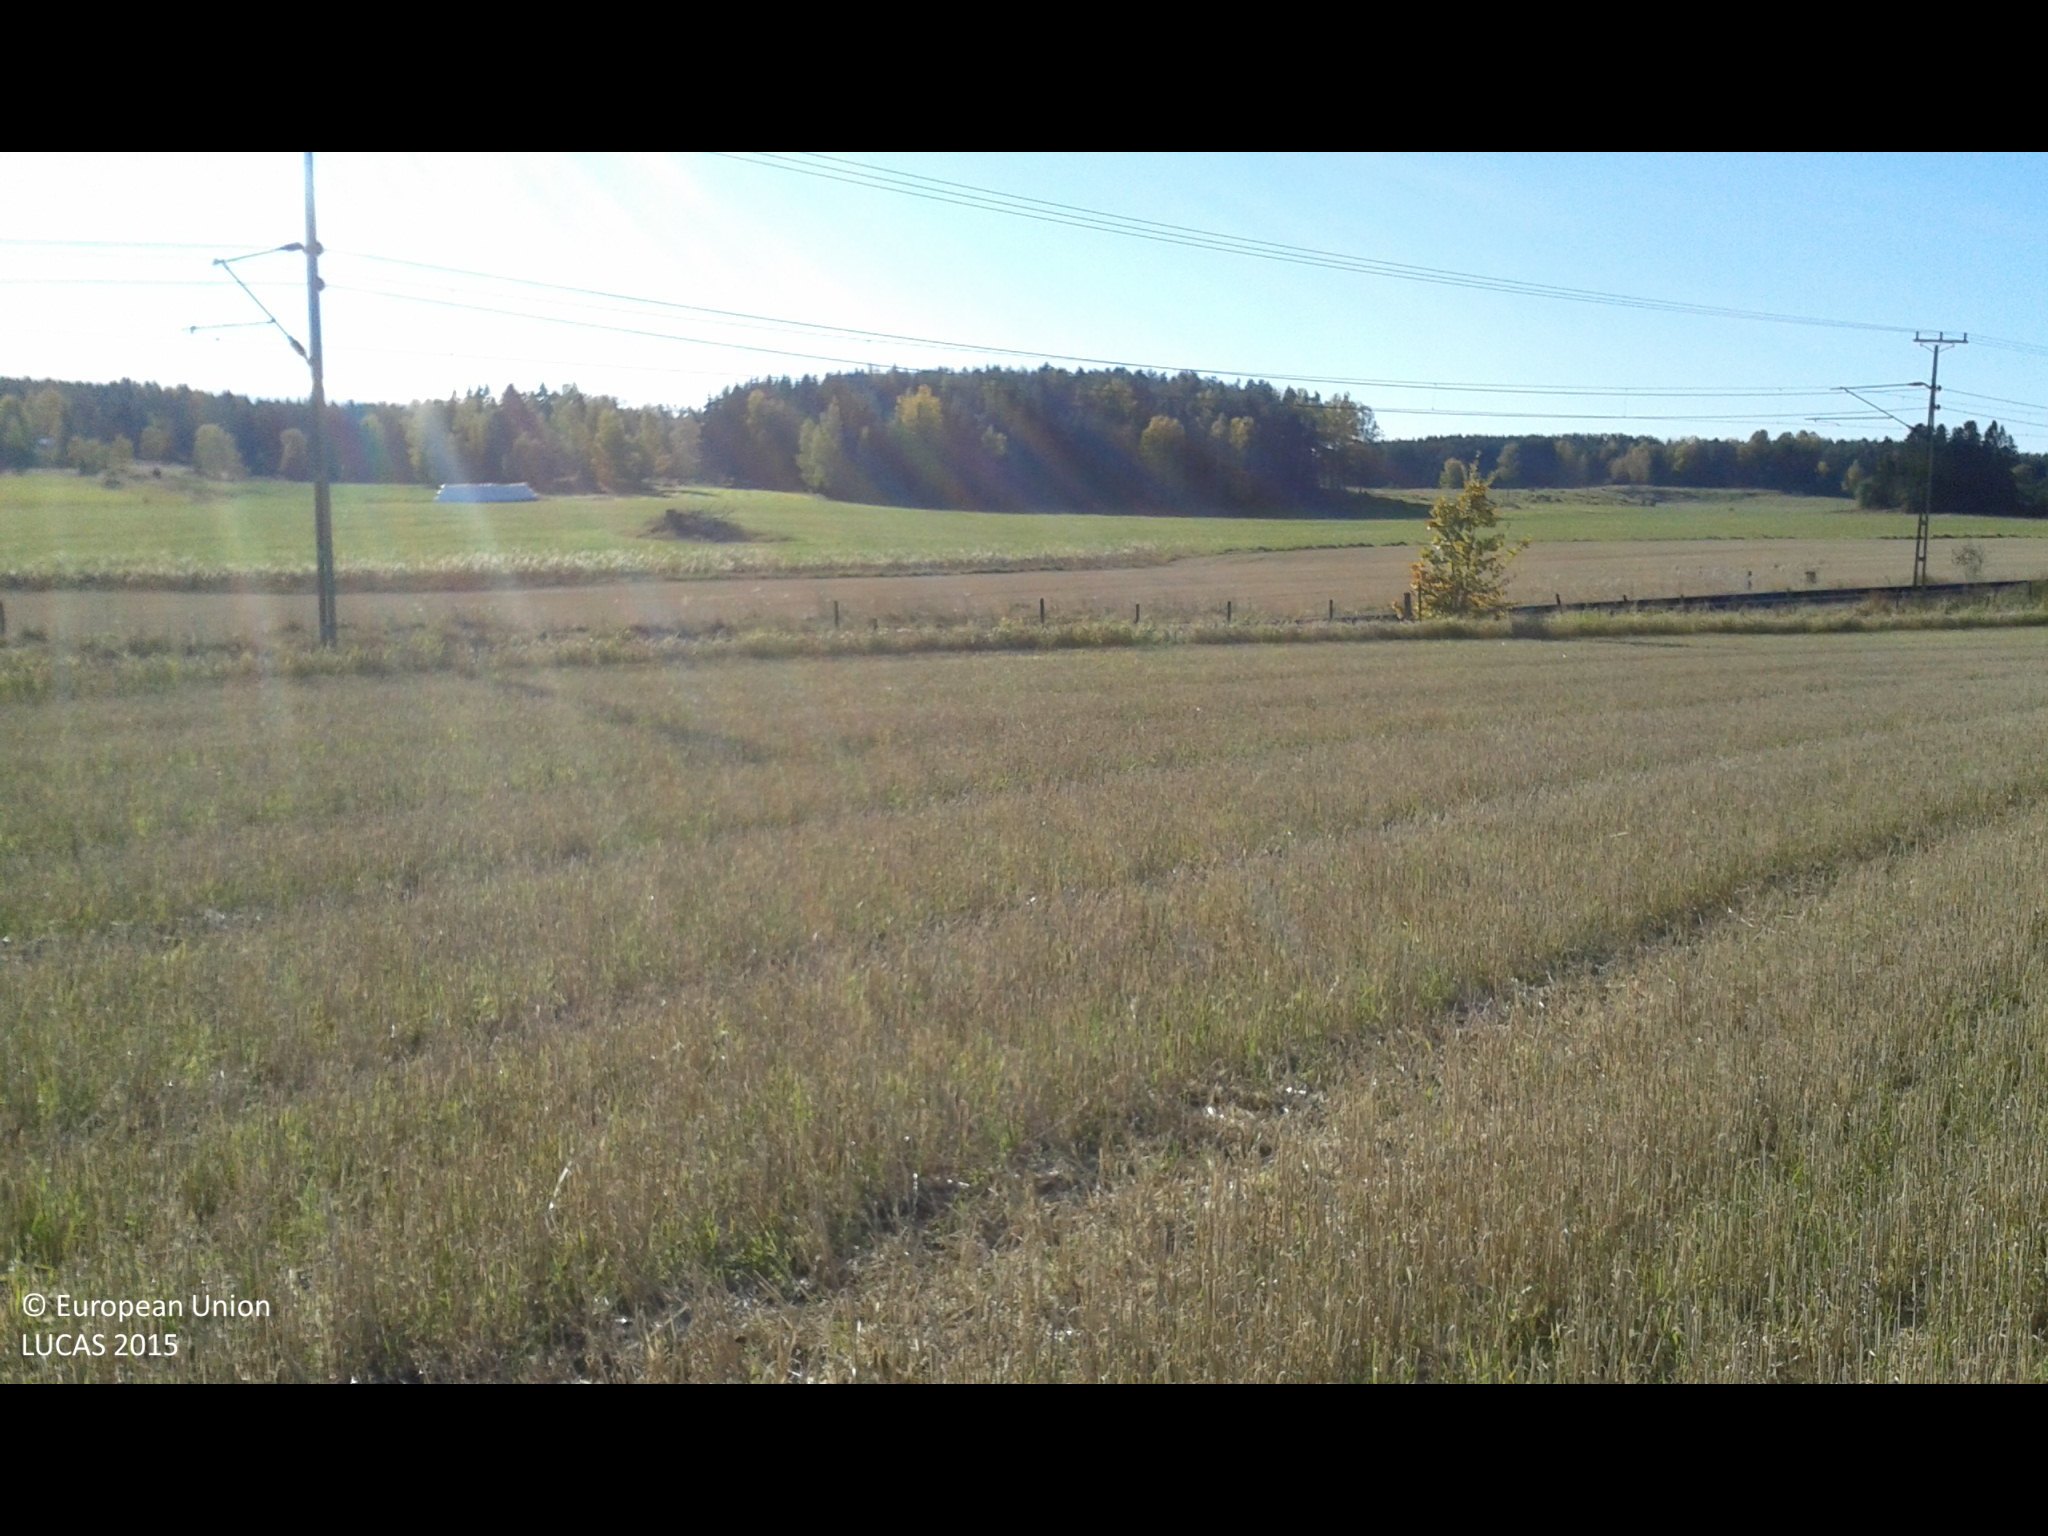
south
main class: Cropland
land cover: Barley
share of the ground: < 10 %
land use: Agriculture (excluding fallow land and kitchen gardens)
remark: Harvested field
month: October
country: SE
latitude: 58.8545
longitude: 17.2603
